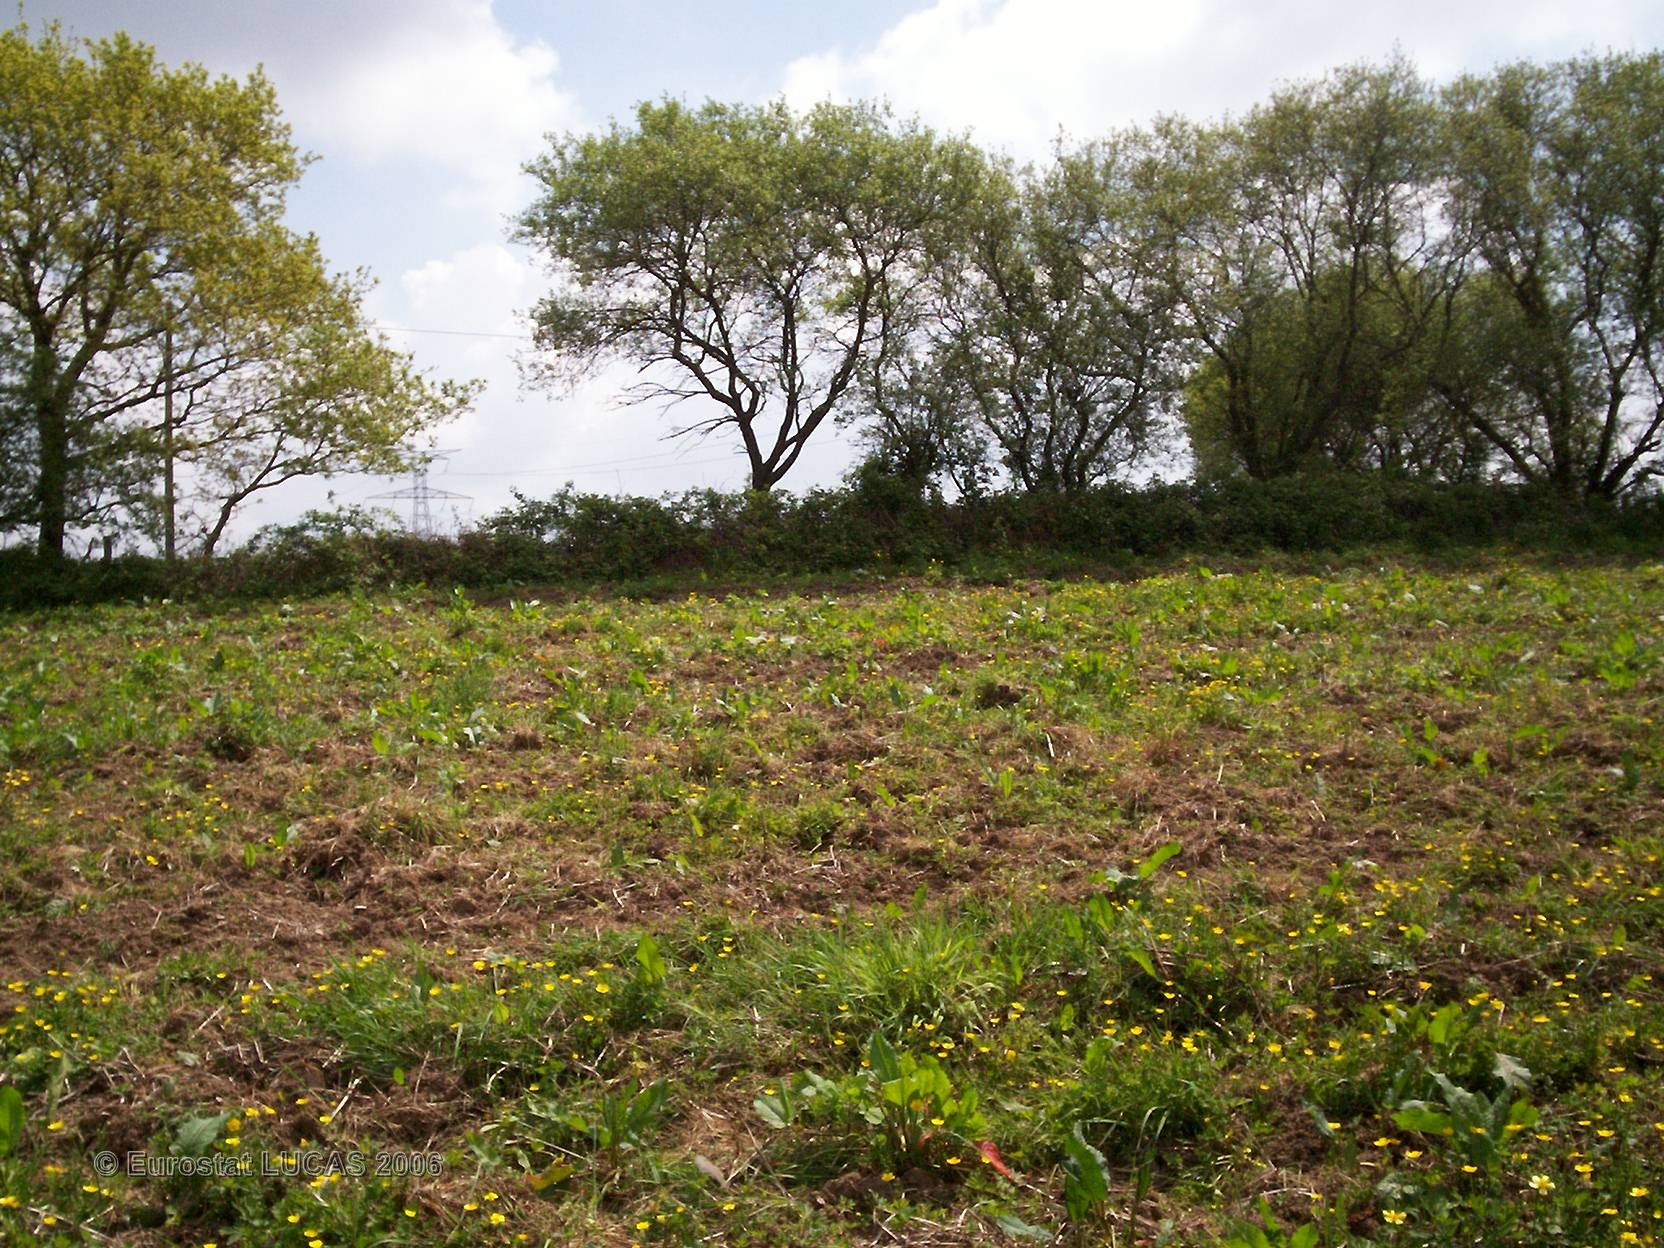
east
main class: Grassland
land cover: Grassland without tree/shrub cover
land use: Fallow land
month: May
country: FR
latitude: 48.1358
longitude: -3.9401
